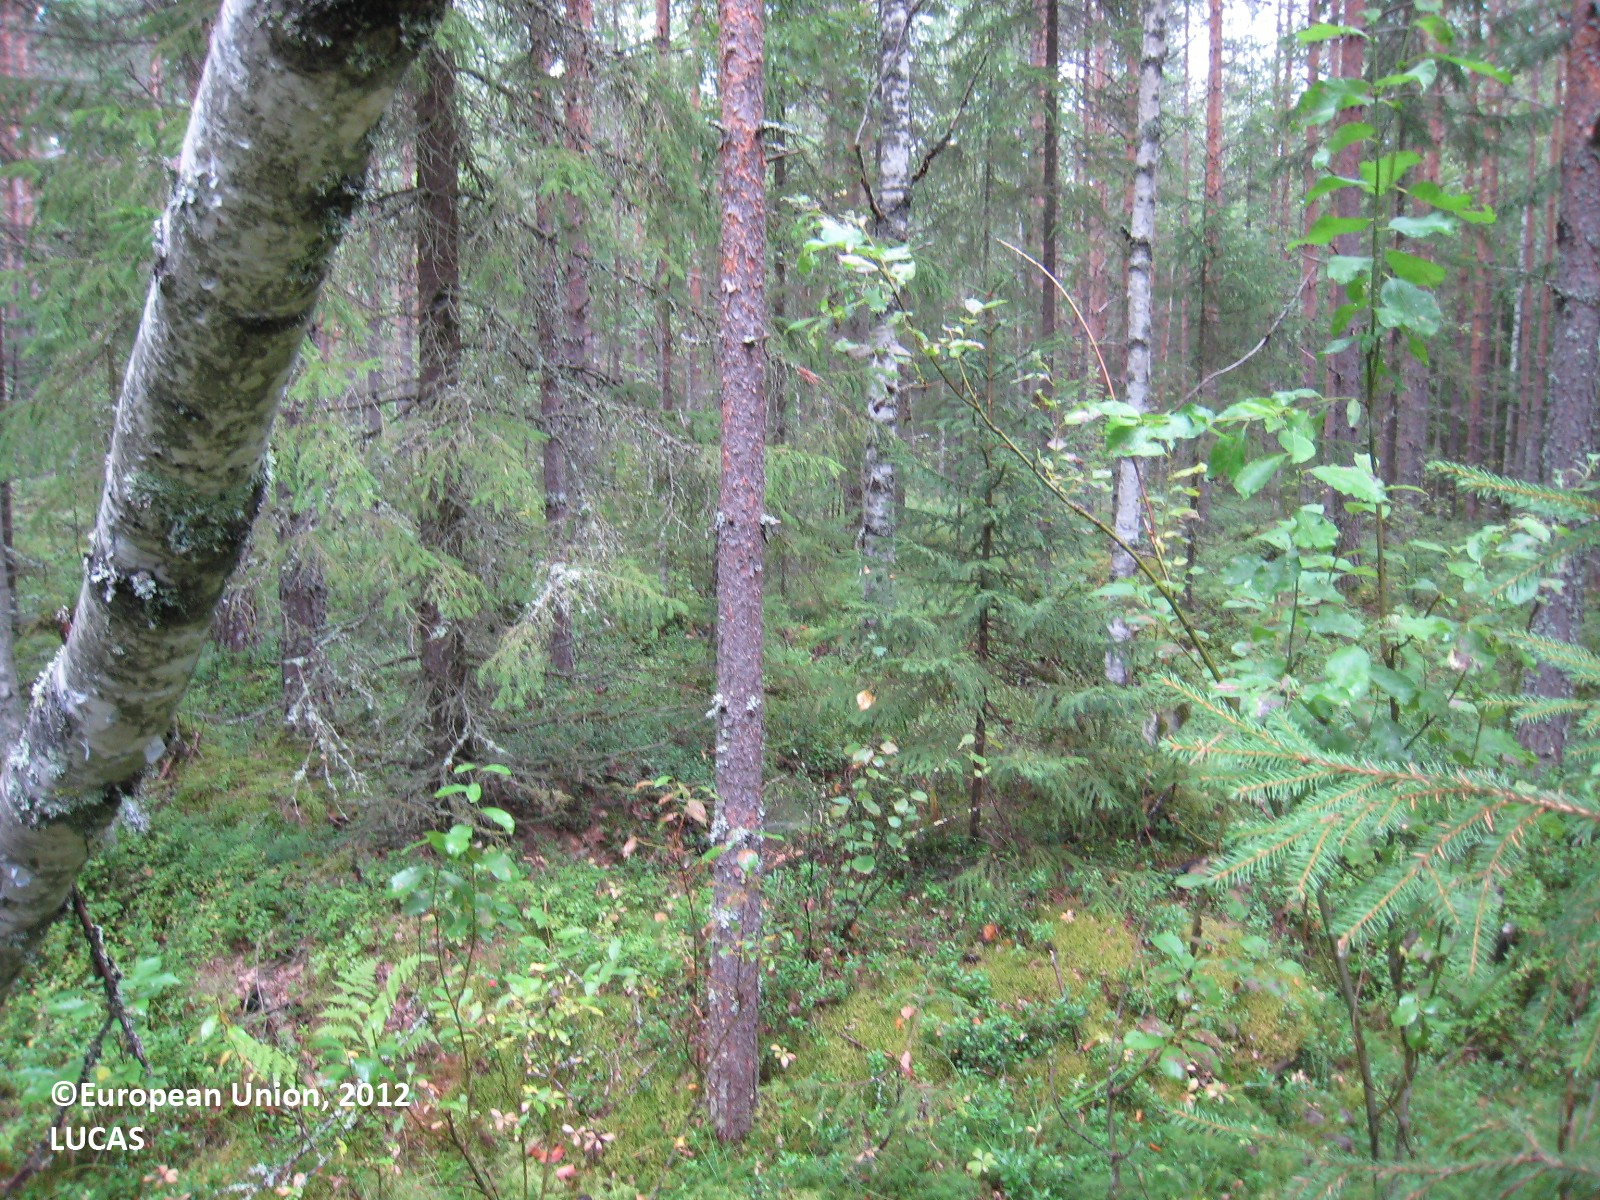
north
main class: Woodland
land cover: Other mixed woodland
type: boreal forest
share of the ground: 50 - 75 %
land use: Forestry
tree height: > 5 m
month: August
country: FI
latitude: 61.8559
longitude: 26.1941
